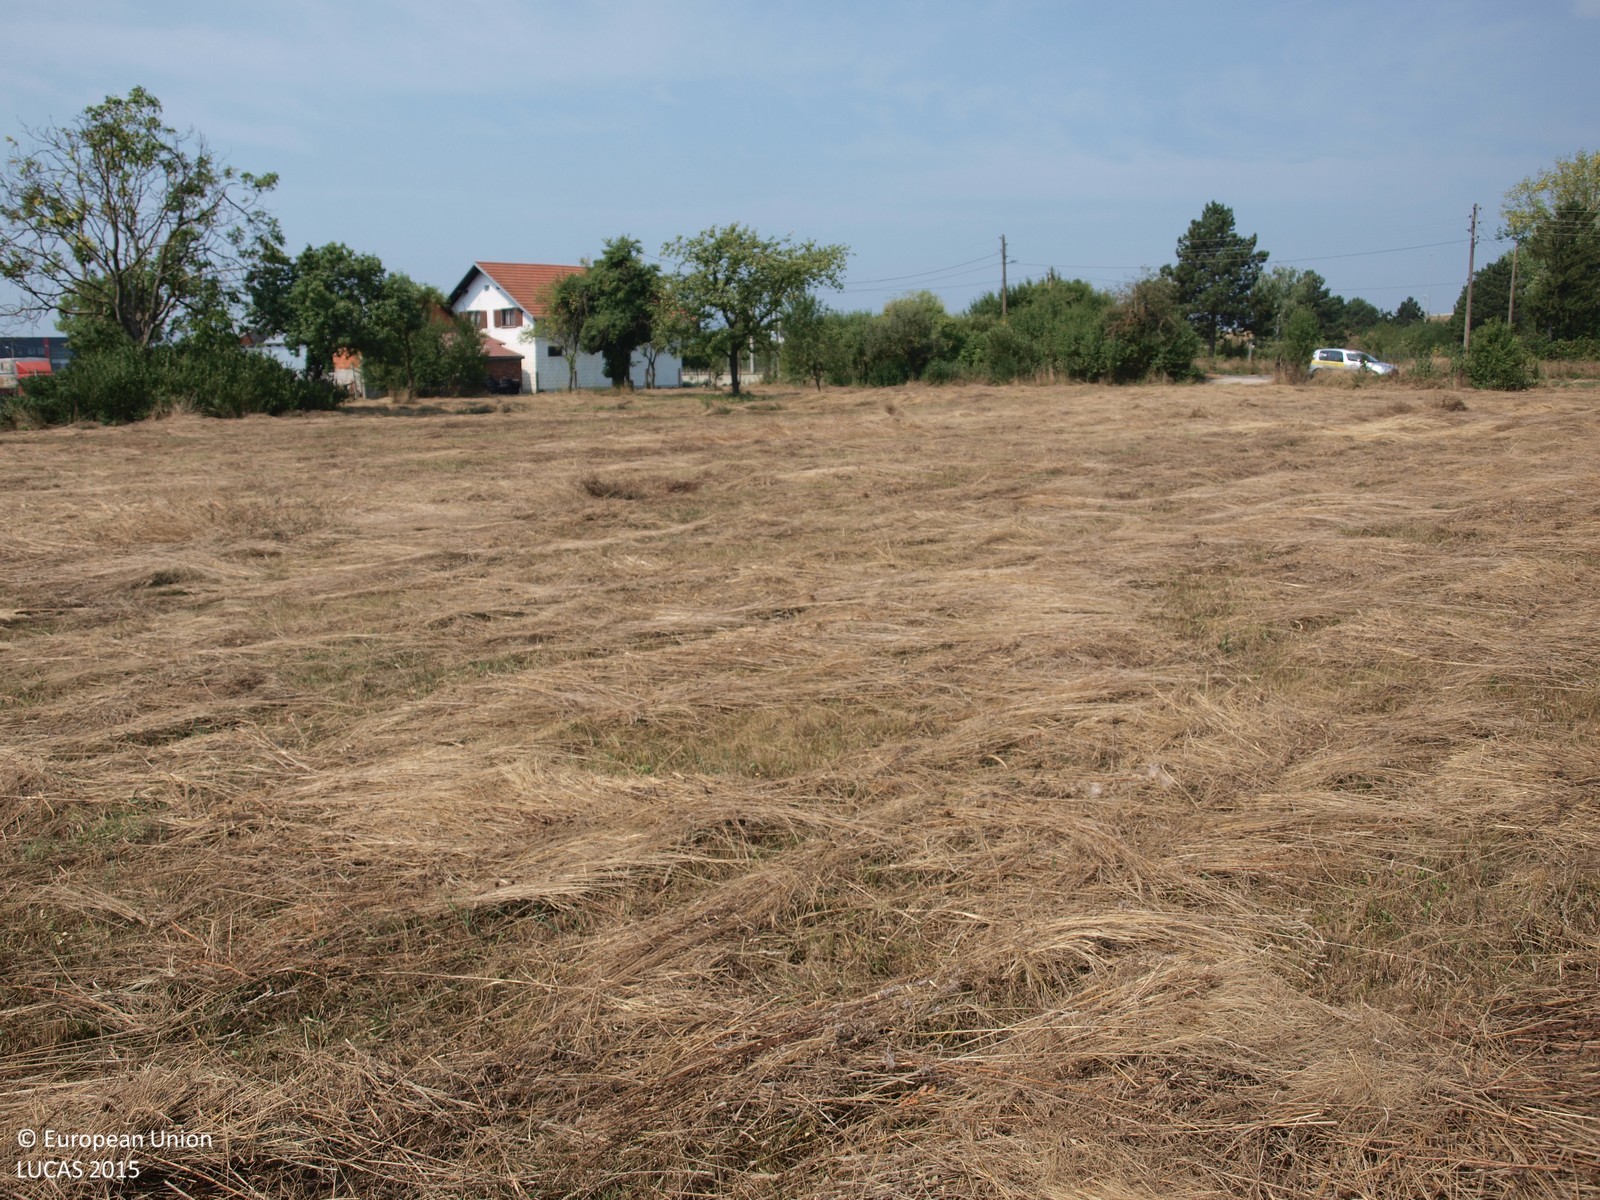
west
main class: Grassland
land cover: Grassland without tree/shrub cover
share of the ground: > 75 %
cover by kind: herbaceous plants 100 %
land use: Agriculture (excluding fallow land and kitchen gardens)
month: August
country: HR
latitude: 45.7550
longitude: 15.8984
